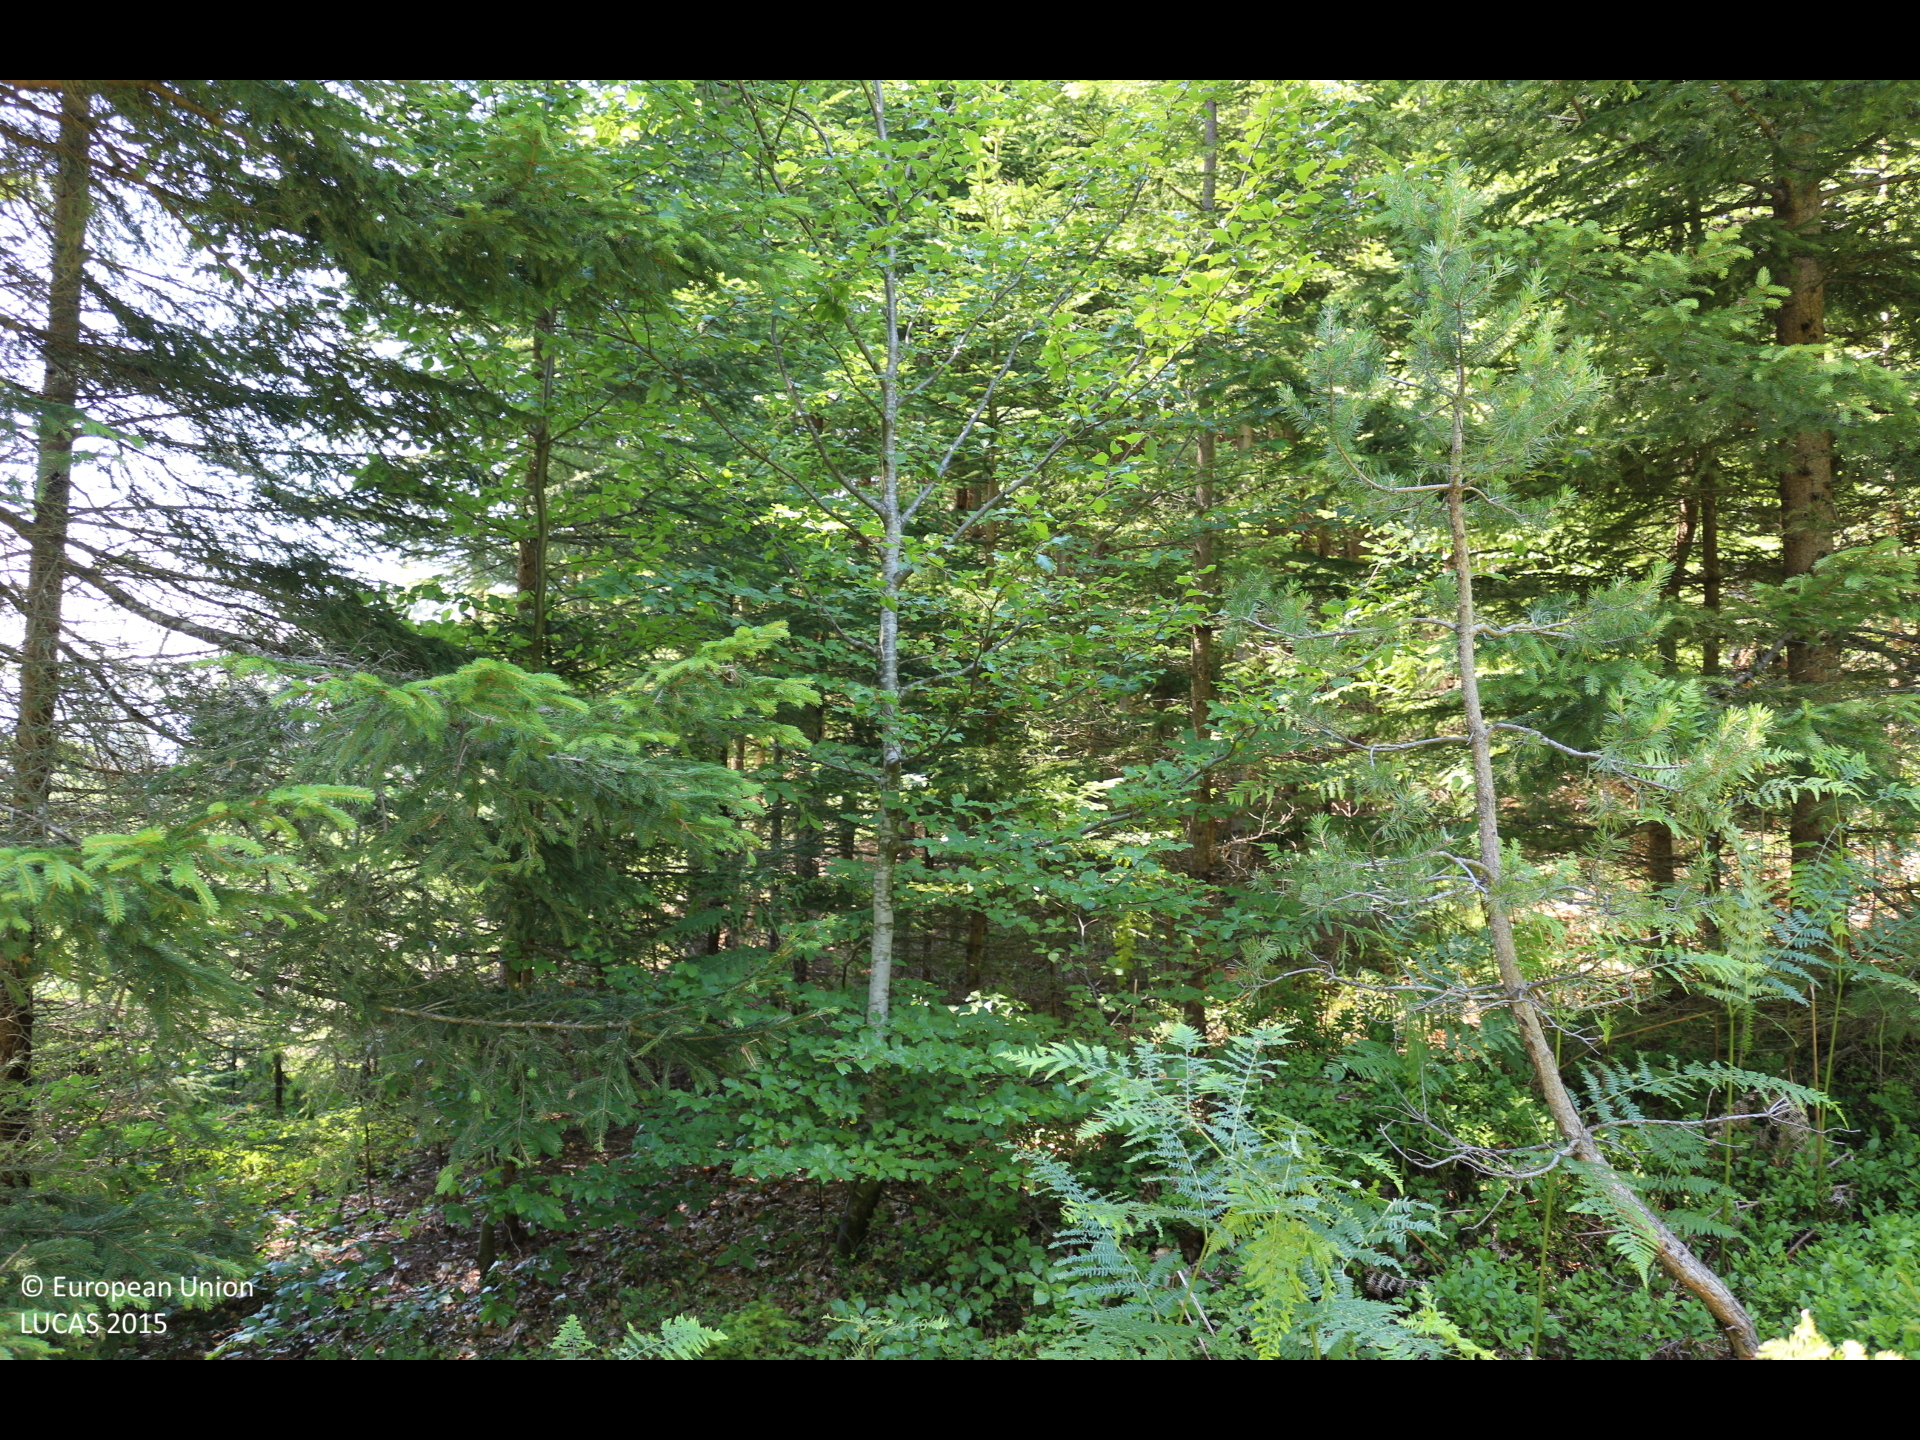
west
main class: Shrubland
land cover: Shrubland with sparse tree cover
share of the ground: > 75 %
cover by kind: shrubs 95 %, coniferous forest trees 5 %
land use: Forestry
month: July
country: AT
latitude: 46.6155
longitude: 13.5881
